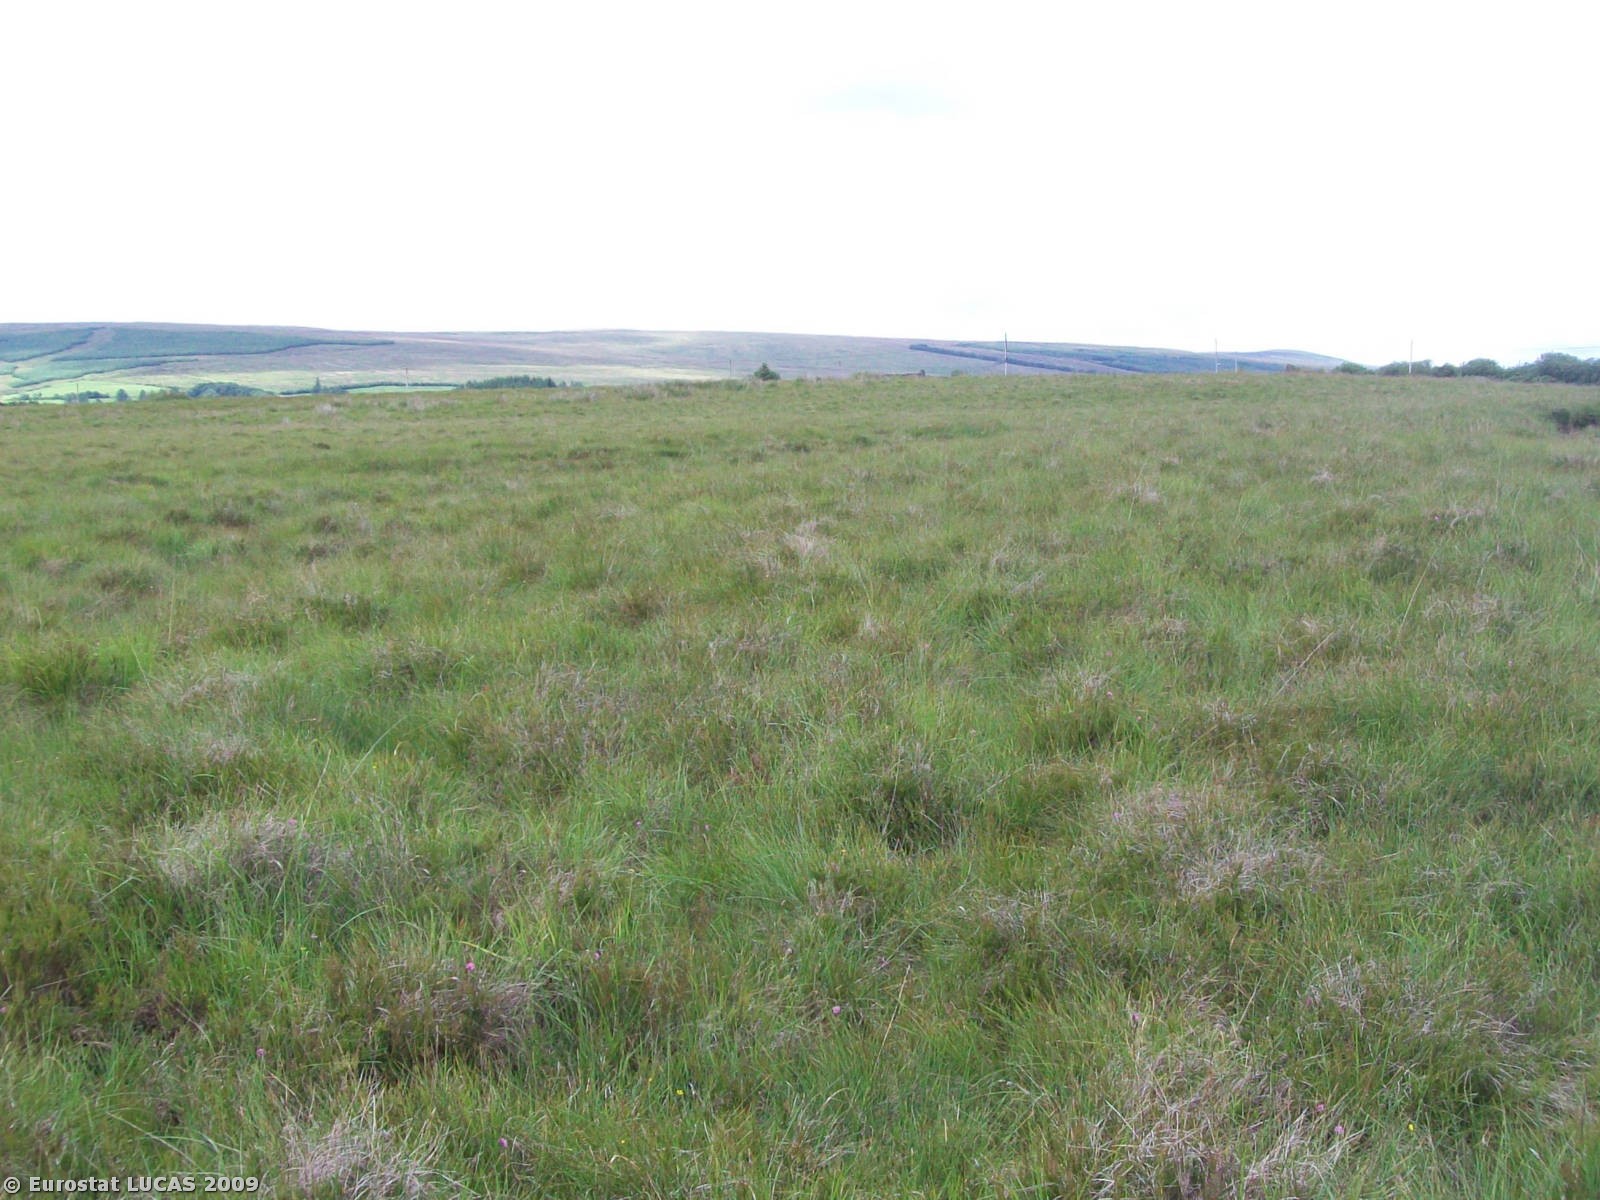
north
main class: Wetlands
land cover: Peatbogs
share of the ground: > 75 %
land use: Unused
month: July
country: GB
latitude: 54.7159
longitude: -6.9491
